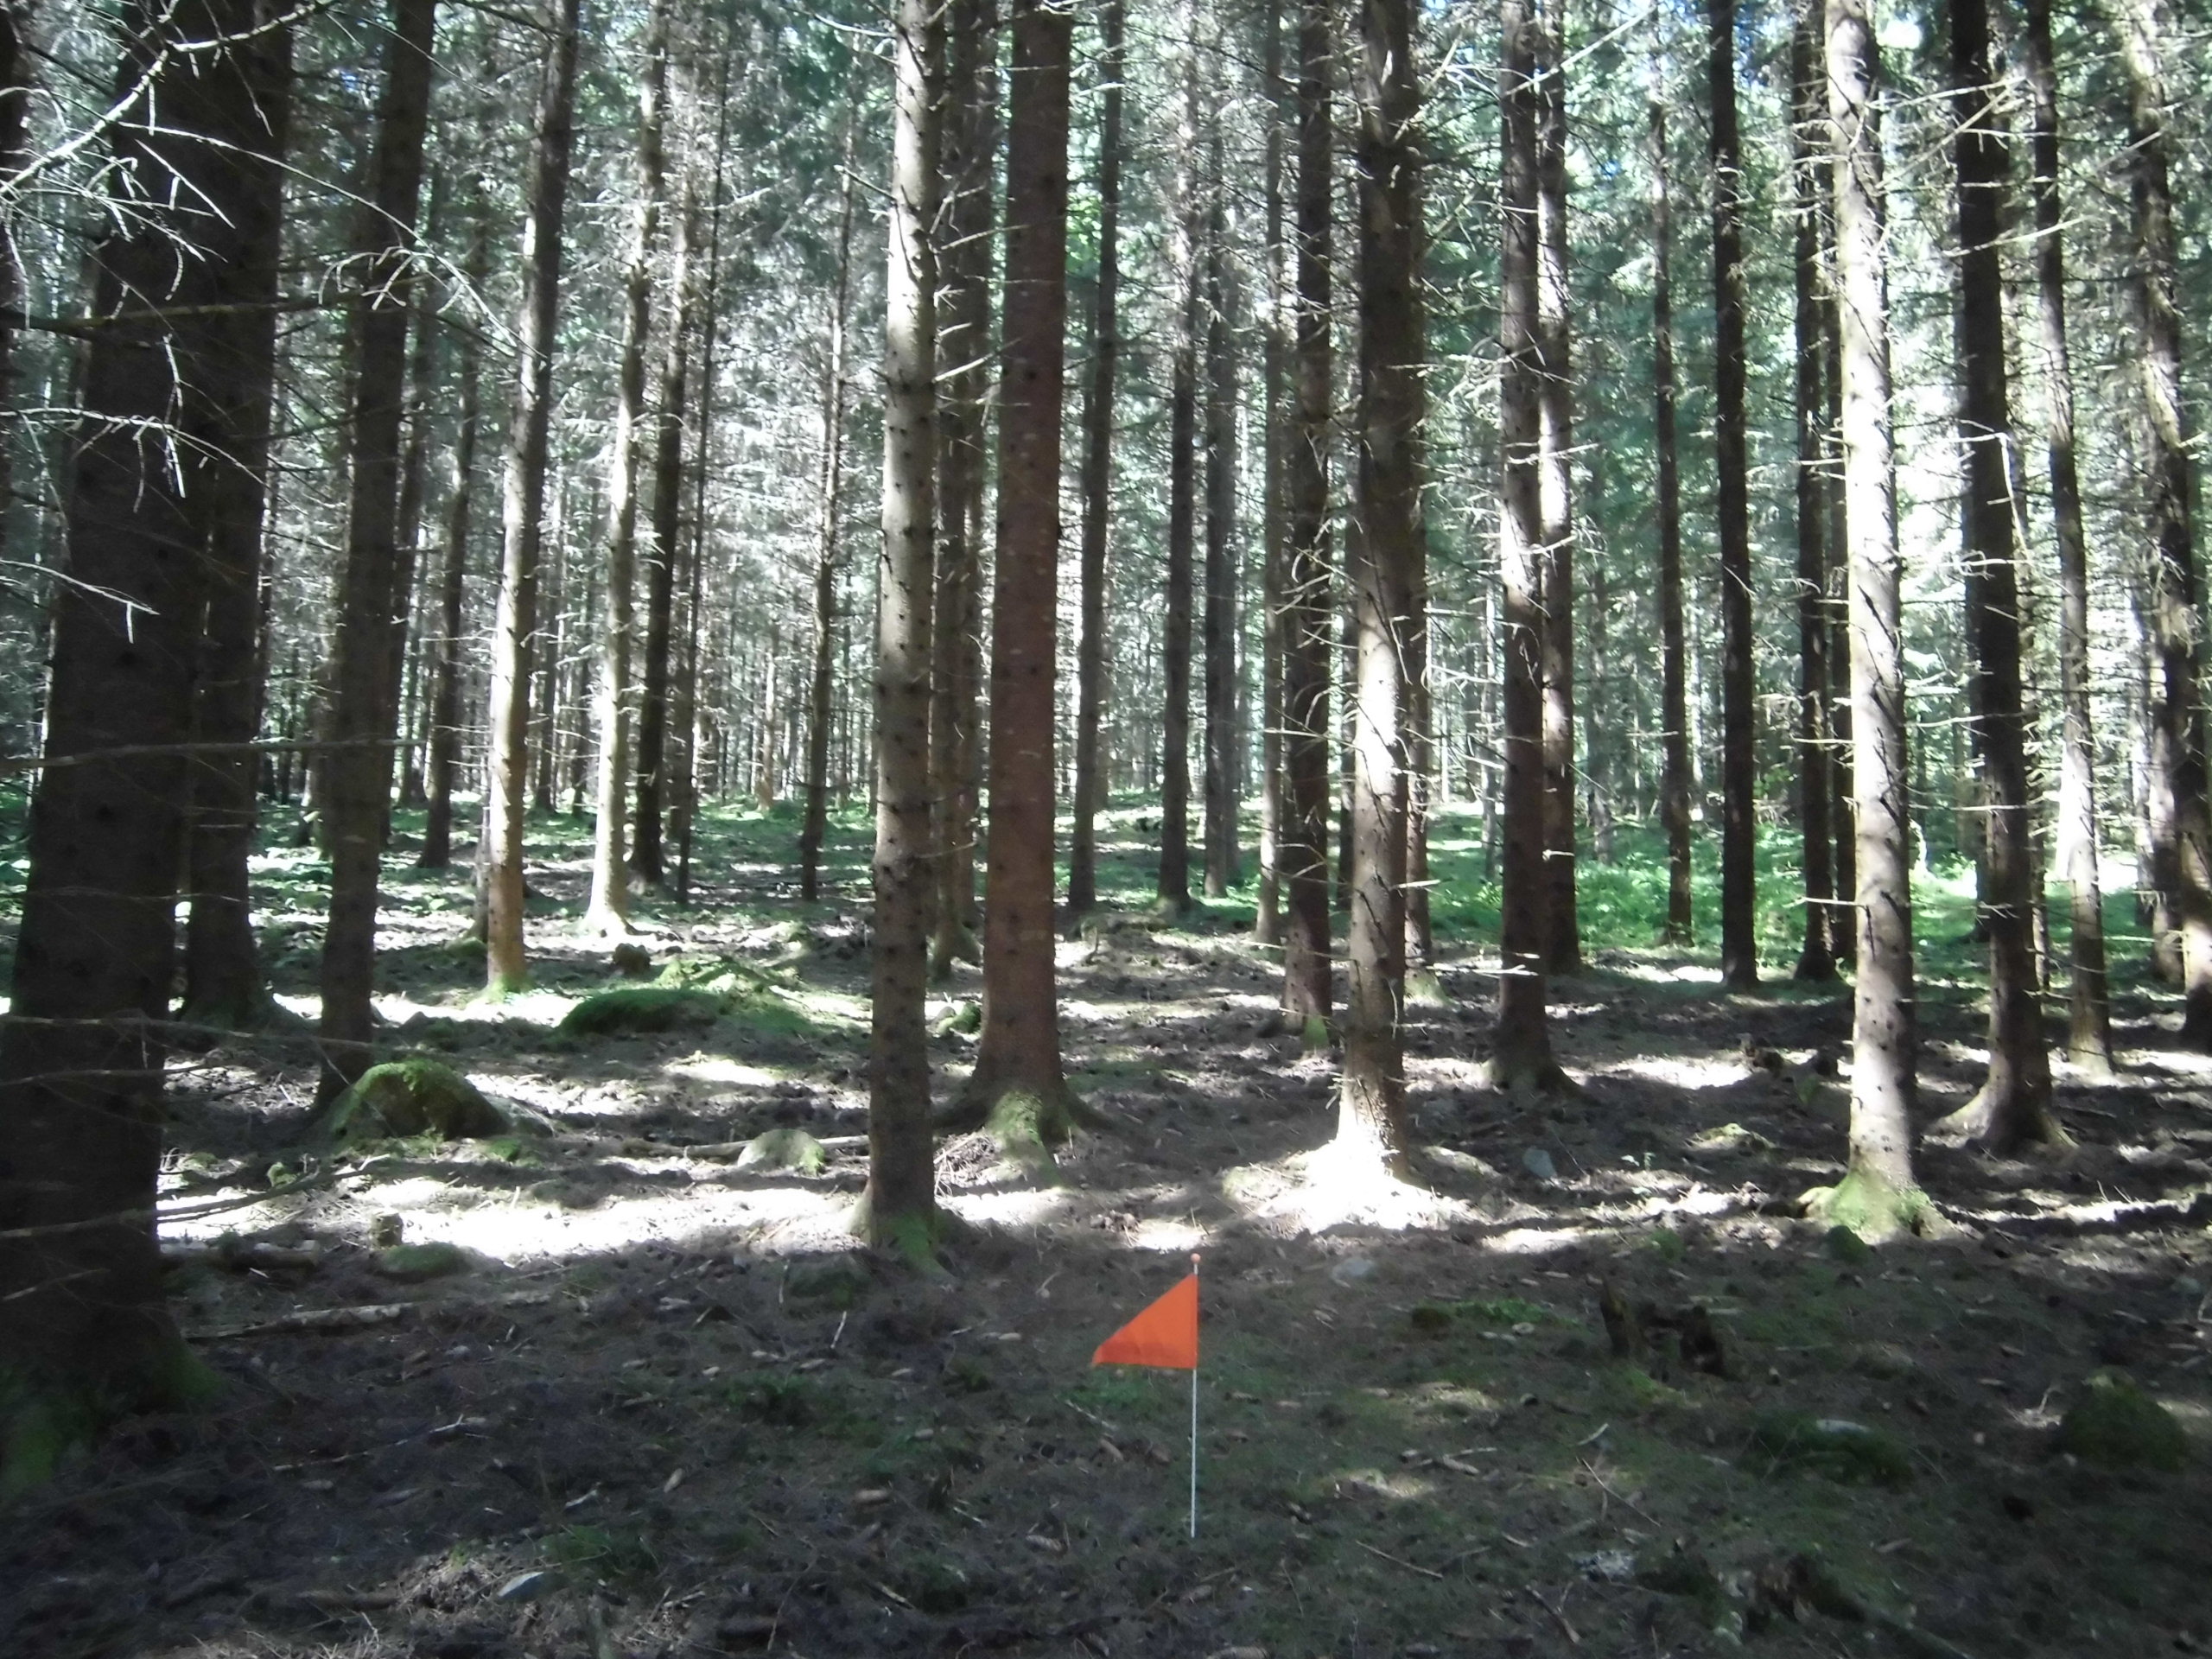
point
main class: Woodland
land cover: Spruce dominated coniferous woodland
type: boreal forest
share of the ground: > 75 %
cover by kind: coniferous forest trees 75 %, unconsolidated bare surface 15 %, lichens and mosses 10 %
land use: Forestry
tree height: > 5 m
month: July
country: SE
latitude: 57.3579
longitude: 15.2994
